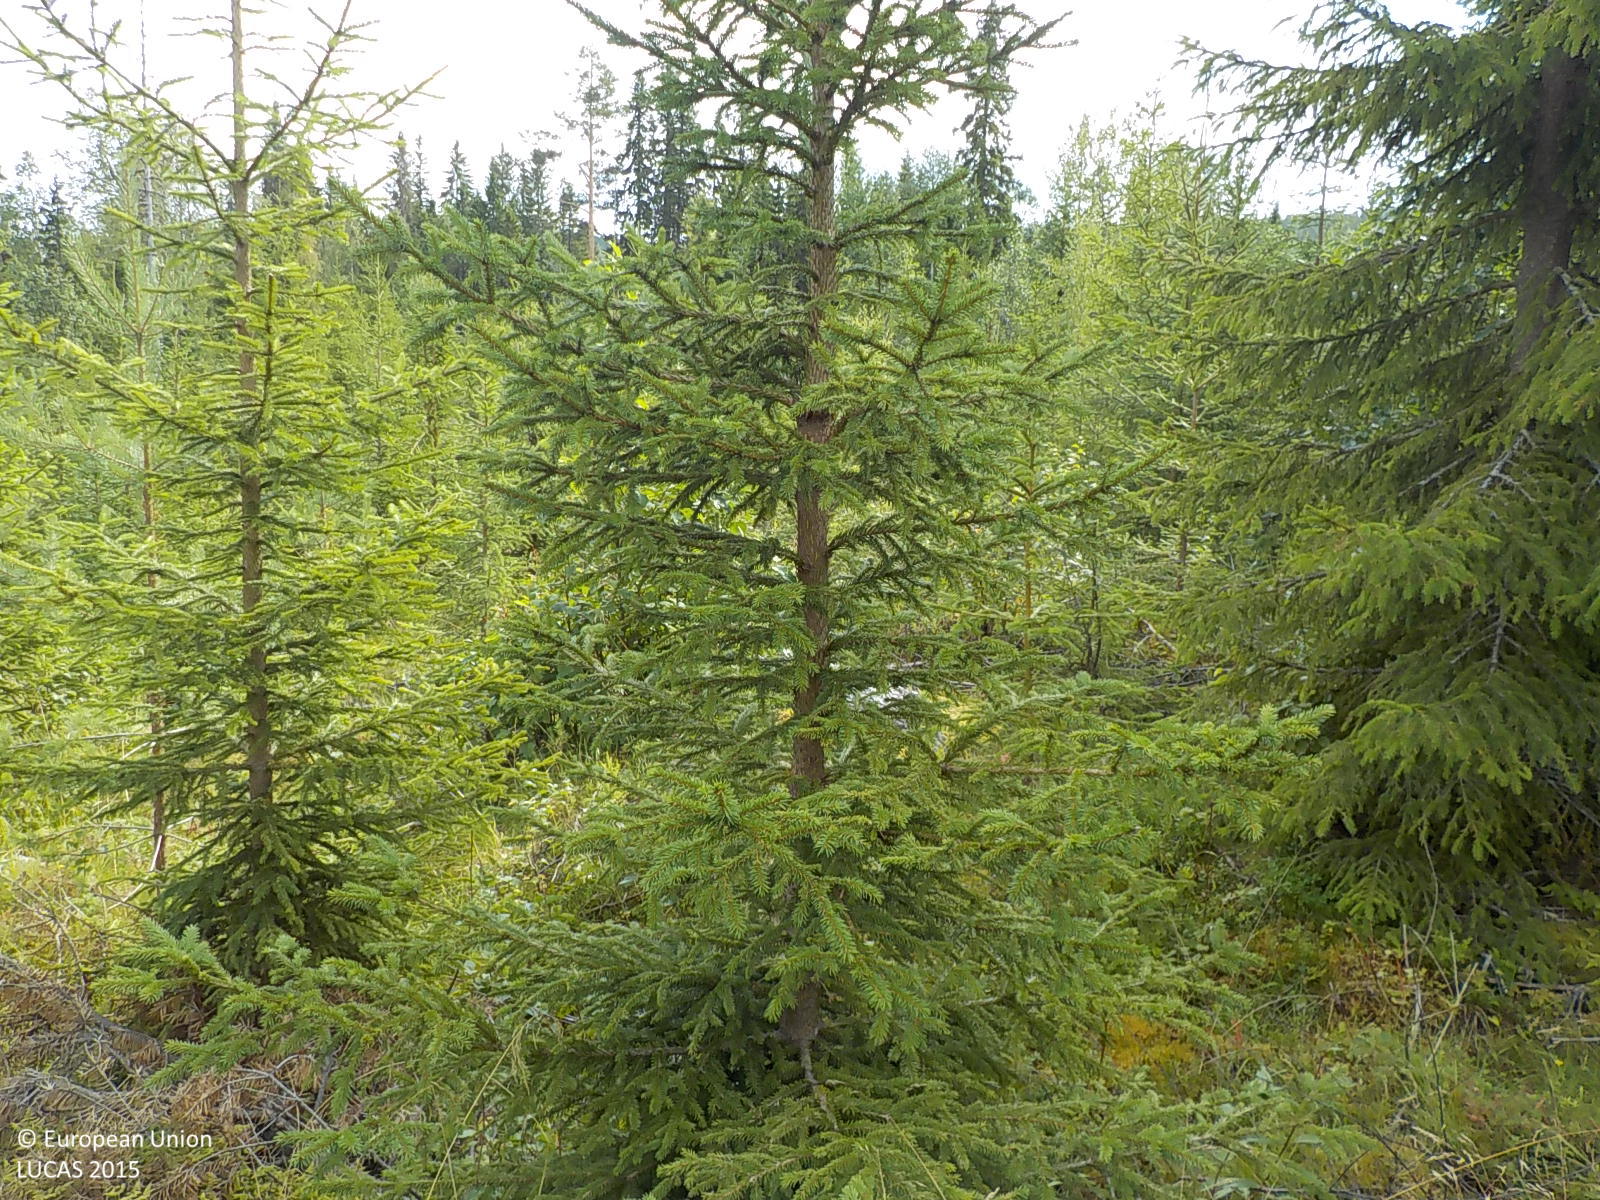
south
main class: Woodland
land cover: Other mixed woodland
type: boreal forest
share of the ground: 50 - 75 %
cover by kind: coniferous forest trees 45 %, shrubs 20 %, herbaceous plants 20 %, broadleaved forest trees 15 %
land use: Forestry
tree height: < 5 m
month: September
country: SE
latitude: 63.3118
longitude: 17.8986
